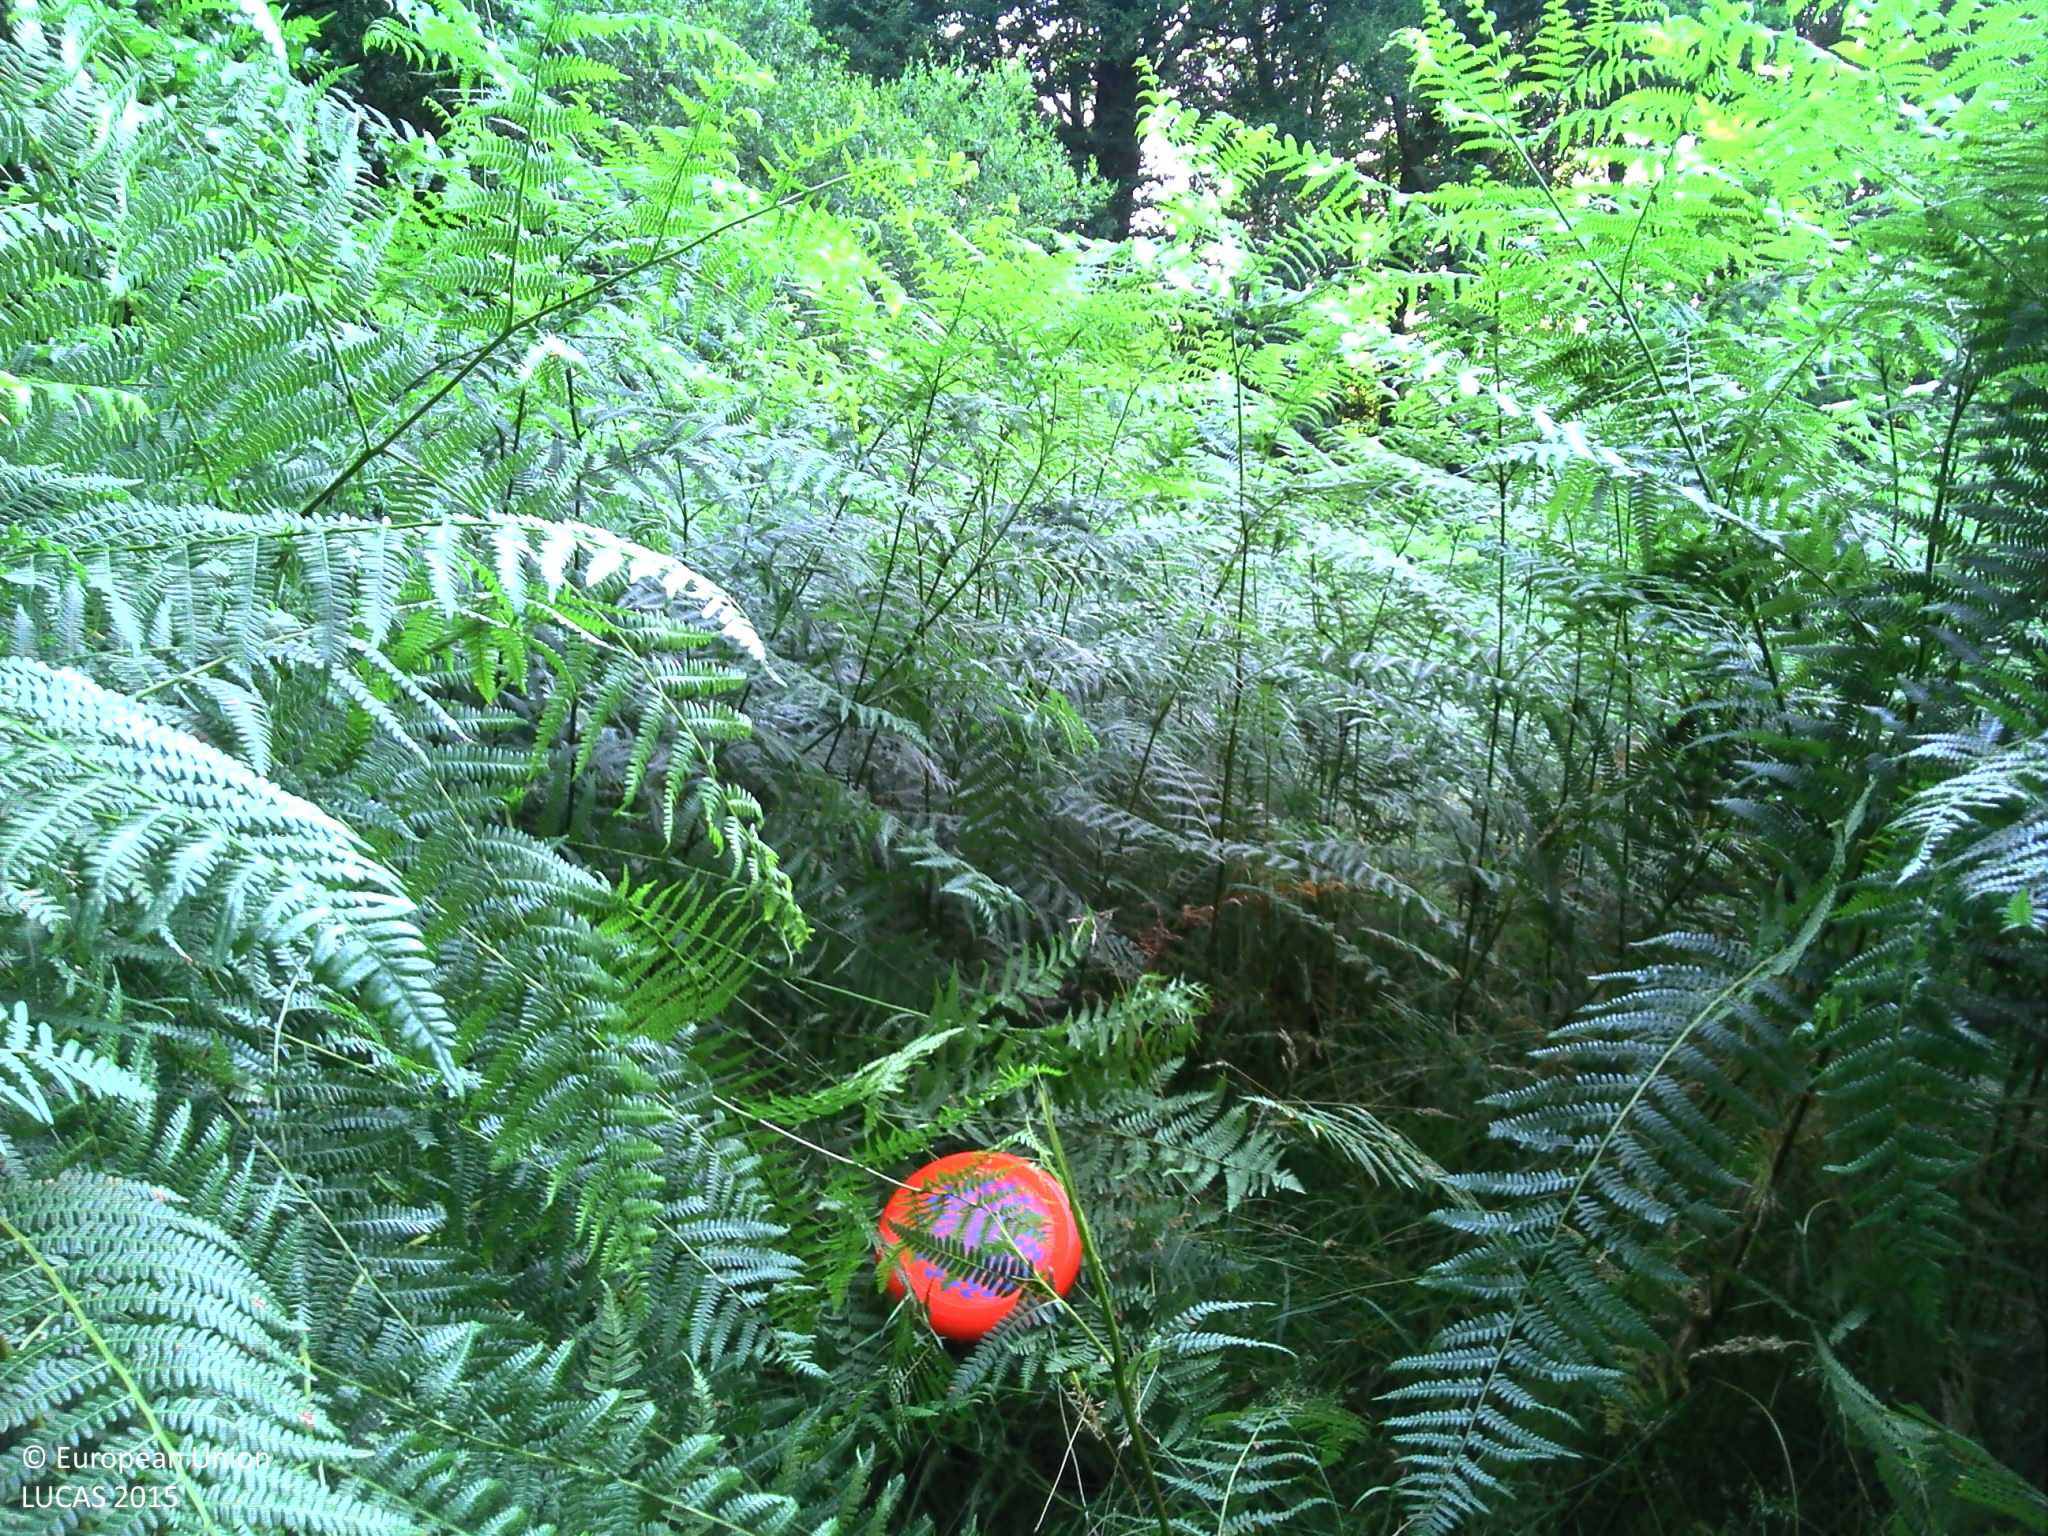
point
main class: Grassland
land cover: Spontaneously vegetated surfaces
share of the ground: > 75 %
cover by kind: herbaceous plants 95 %
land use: Fallow land
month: July
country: FR
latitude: 45.8522
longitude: 1.7645
